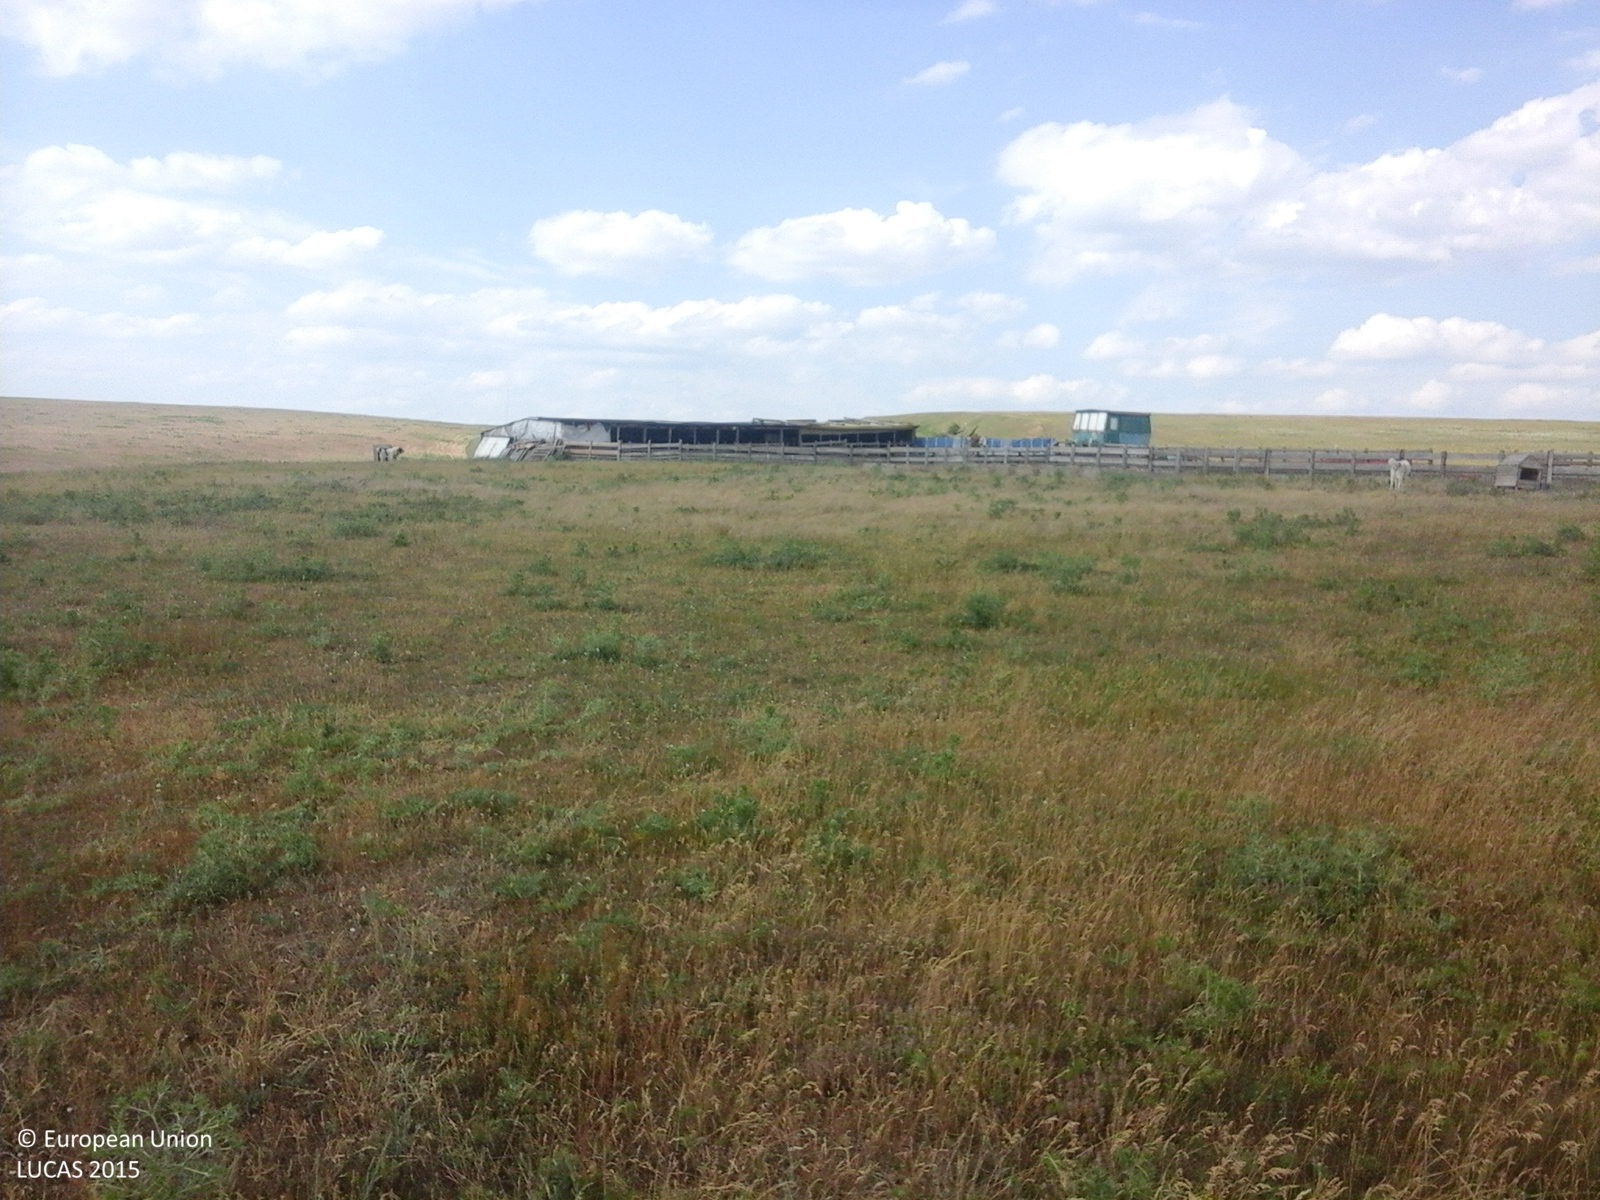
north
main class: Grassland
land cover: Grassland without tree/shrub cover
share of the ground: > 75 %
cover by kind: herbaceous plants 100 %
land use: Agriculture (excluding fallow land and kitchen gardens)
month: June
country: RO
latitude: 47.6754
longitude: 26.3216
